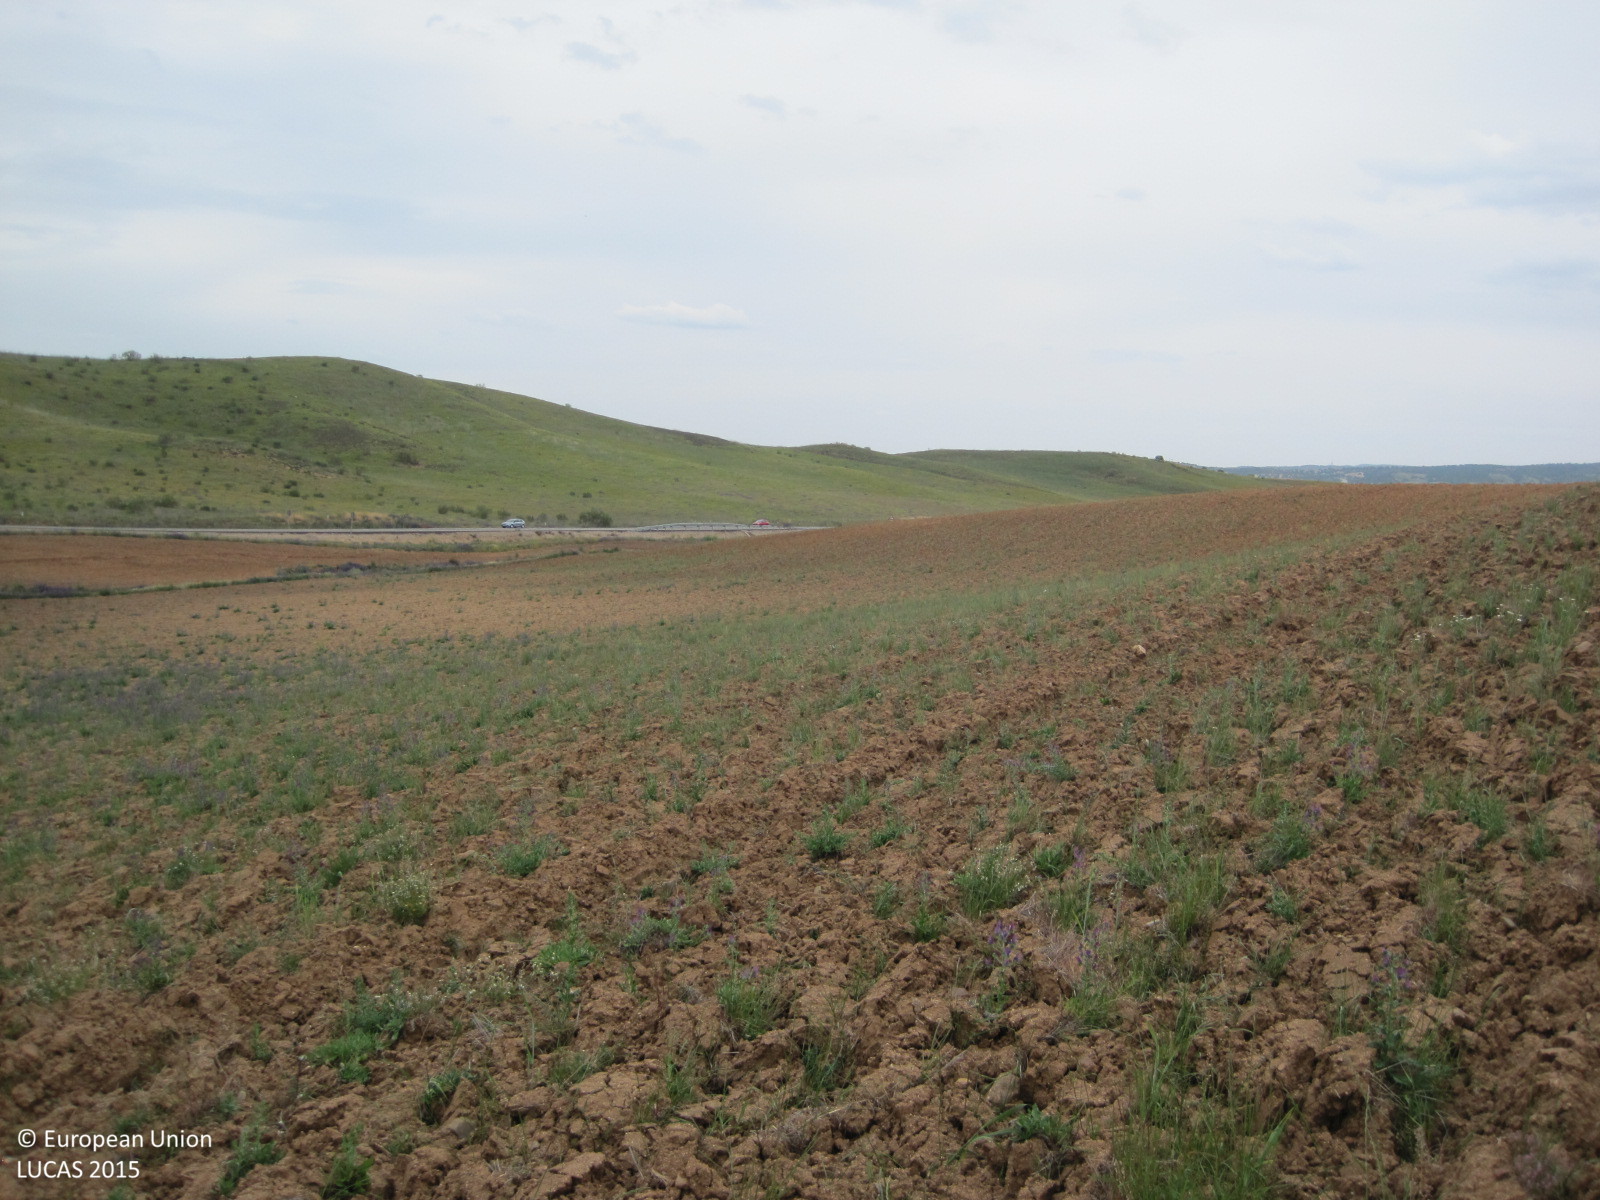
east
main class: Grassland
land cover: Spontaneously vegetated surfaces
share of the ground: 25 - 50 %
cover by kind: unconsolidated bare surface 70 %, herbaceous plants 30 %
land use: Fallow land
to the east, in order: Spontaneously vegetated surfaces; Grass margins
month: April
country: ES
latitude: 39.8822
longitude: -4.2450
